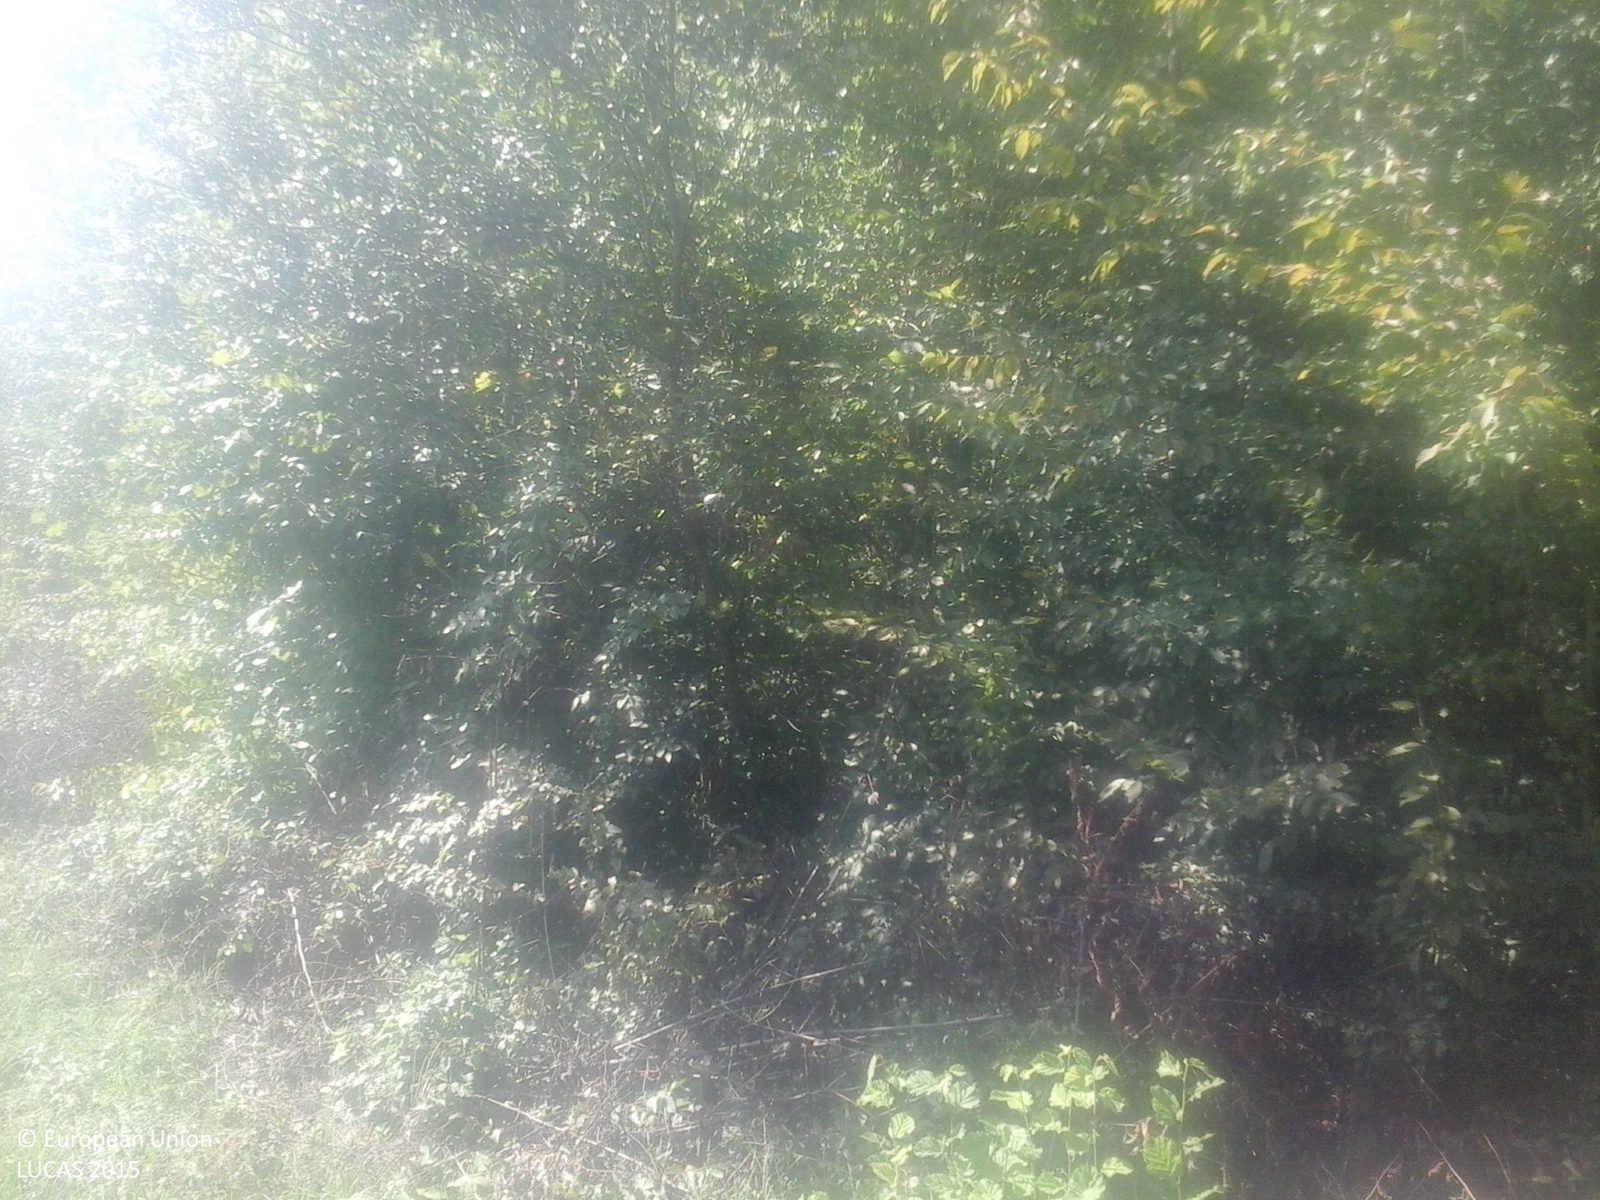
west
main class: Woodland
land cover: Broadleaved woodland
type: acidophilous oak and oak-birch forest
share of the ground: > 75 %
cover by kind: broadleaved forest trees 100 %
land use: Forestry
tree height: > 5 m
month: September
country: RO
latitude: 46.6586
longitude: 22.2943
